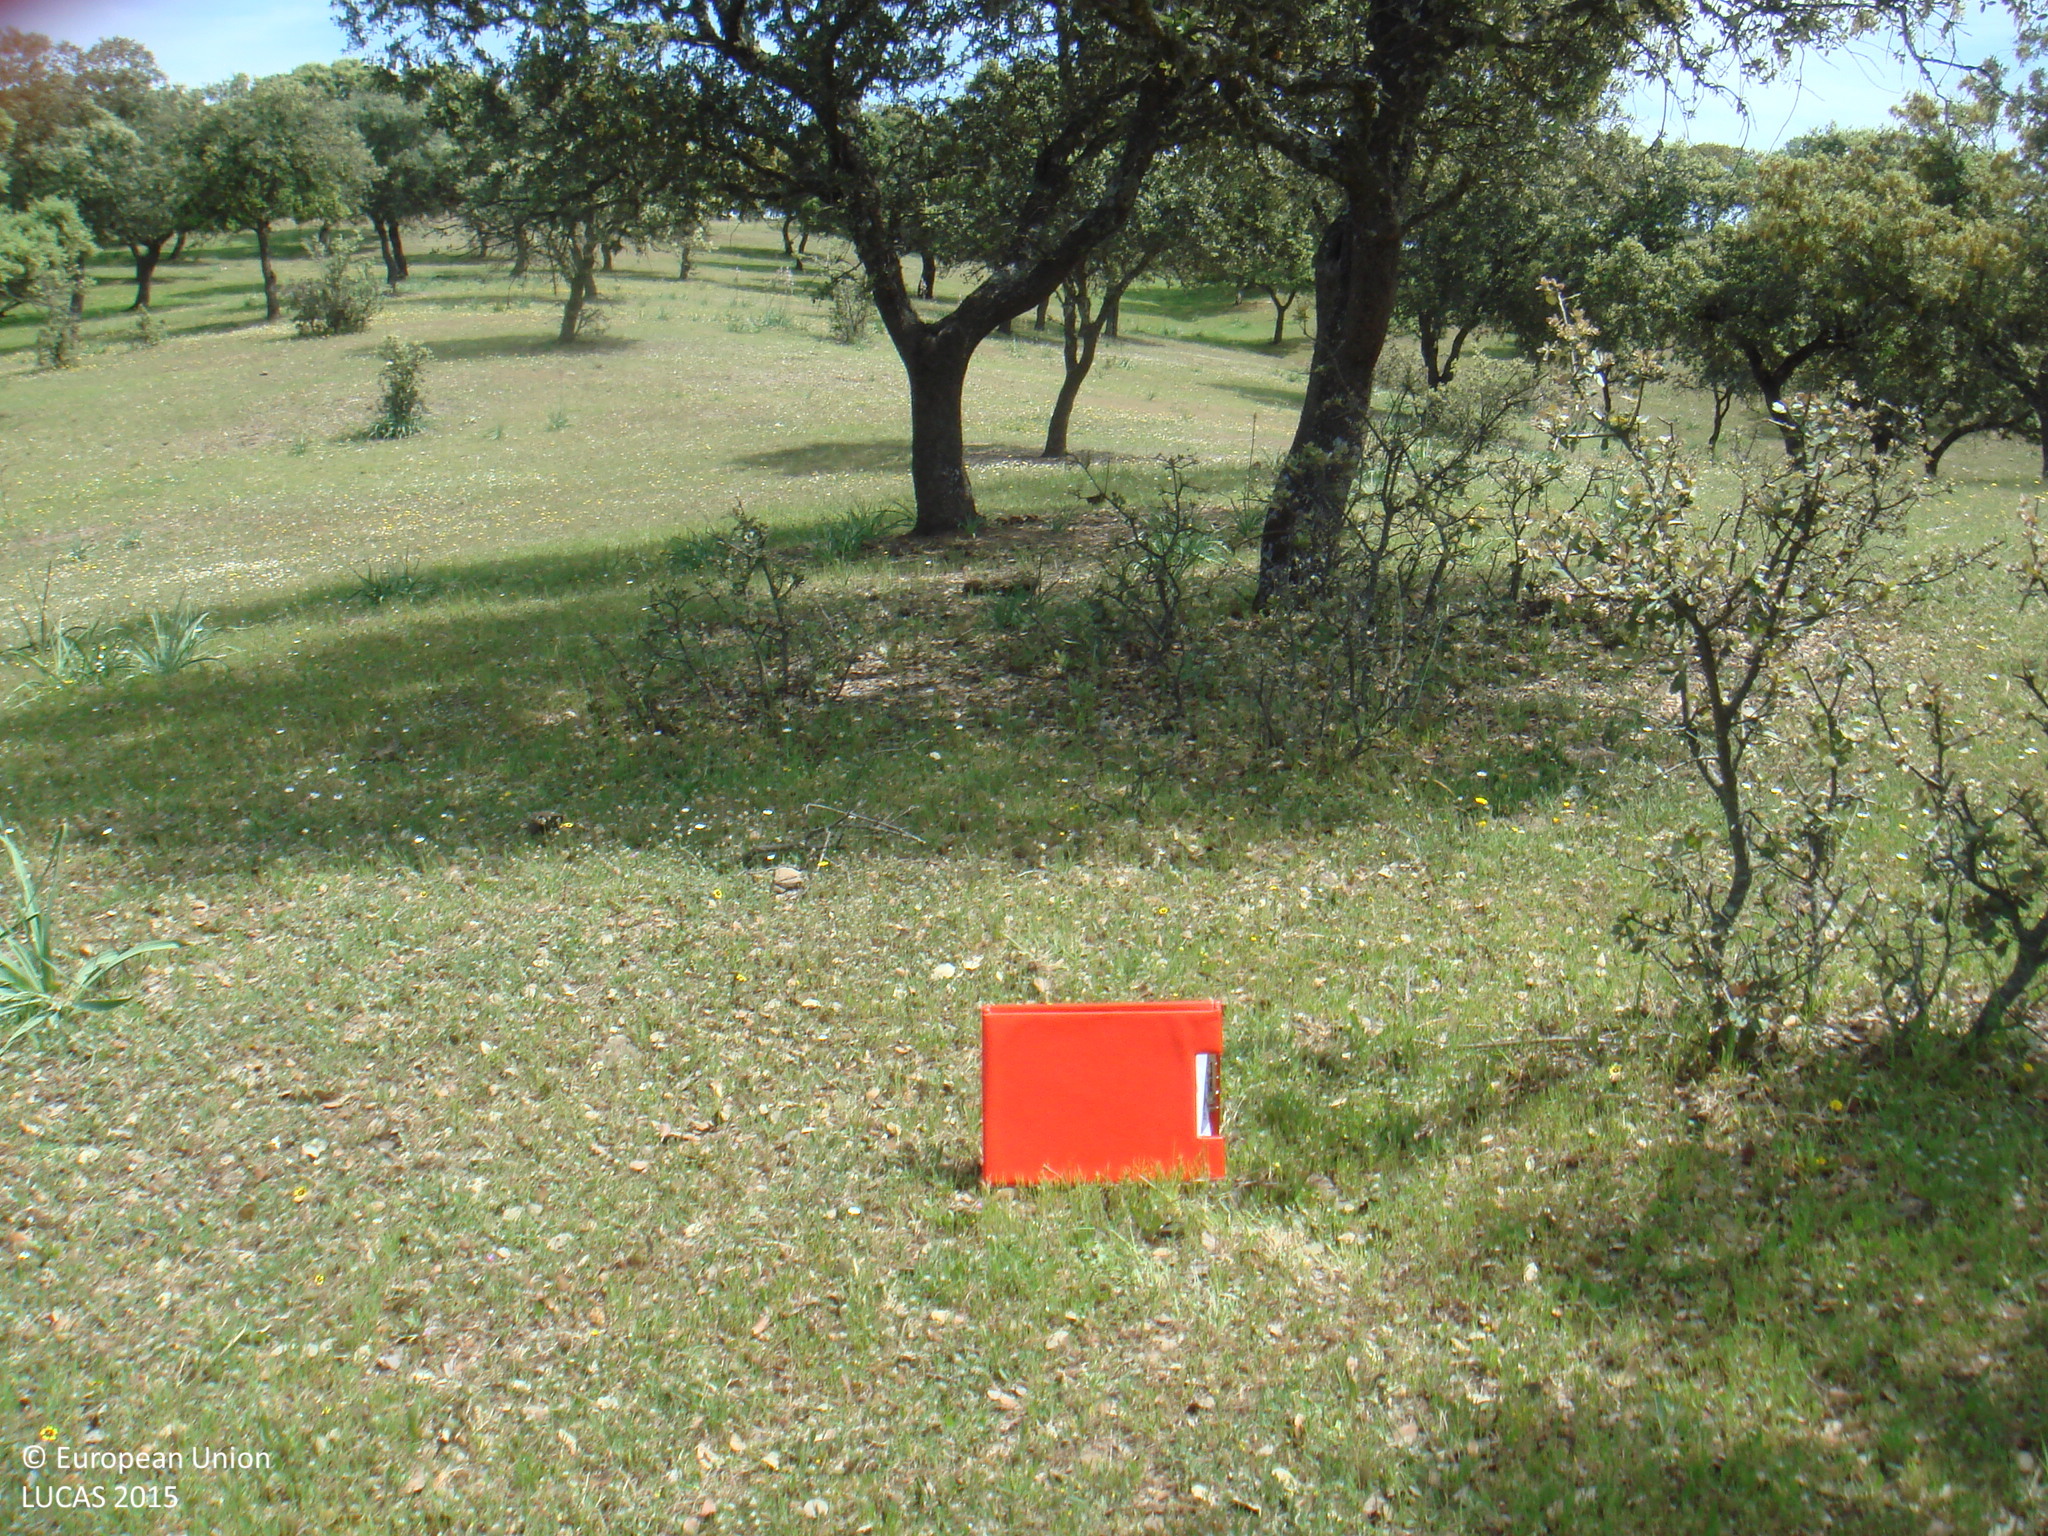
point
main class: Woodland
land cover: Broadleaved woodland
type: broadleaved evergreen forest
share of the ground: > 75 %
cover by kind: broadleaved forest trees 80 %, coniferous forest trees 20 %
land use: Forestry
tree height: > 5 m
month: April
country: ES
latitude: 38.1817
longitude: -4.6879
